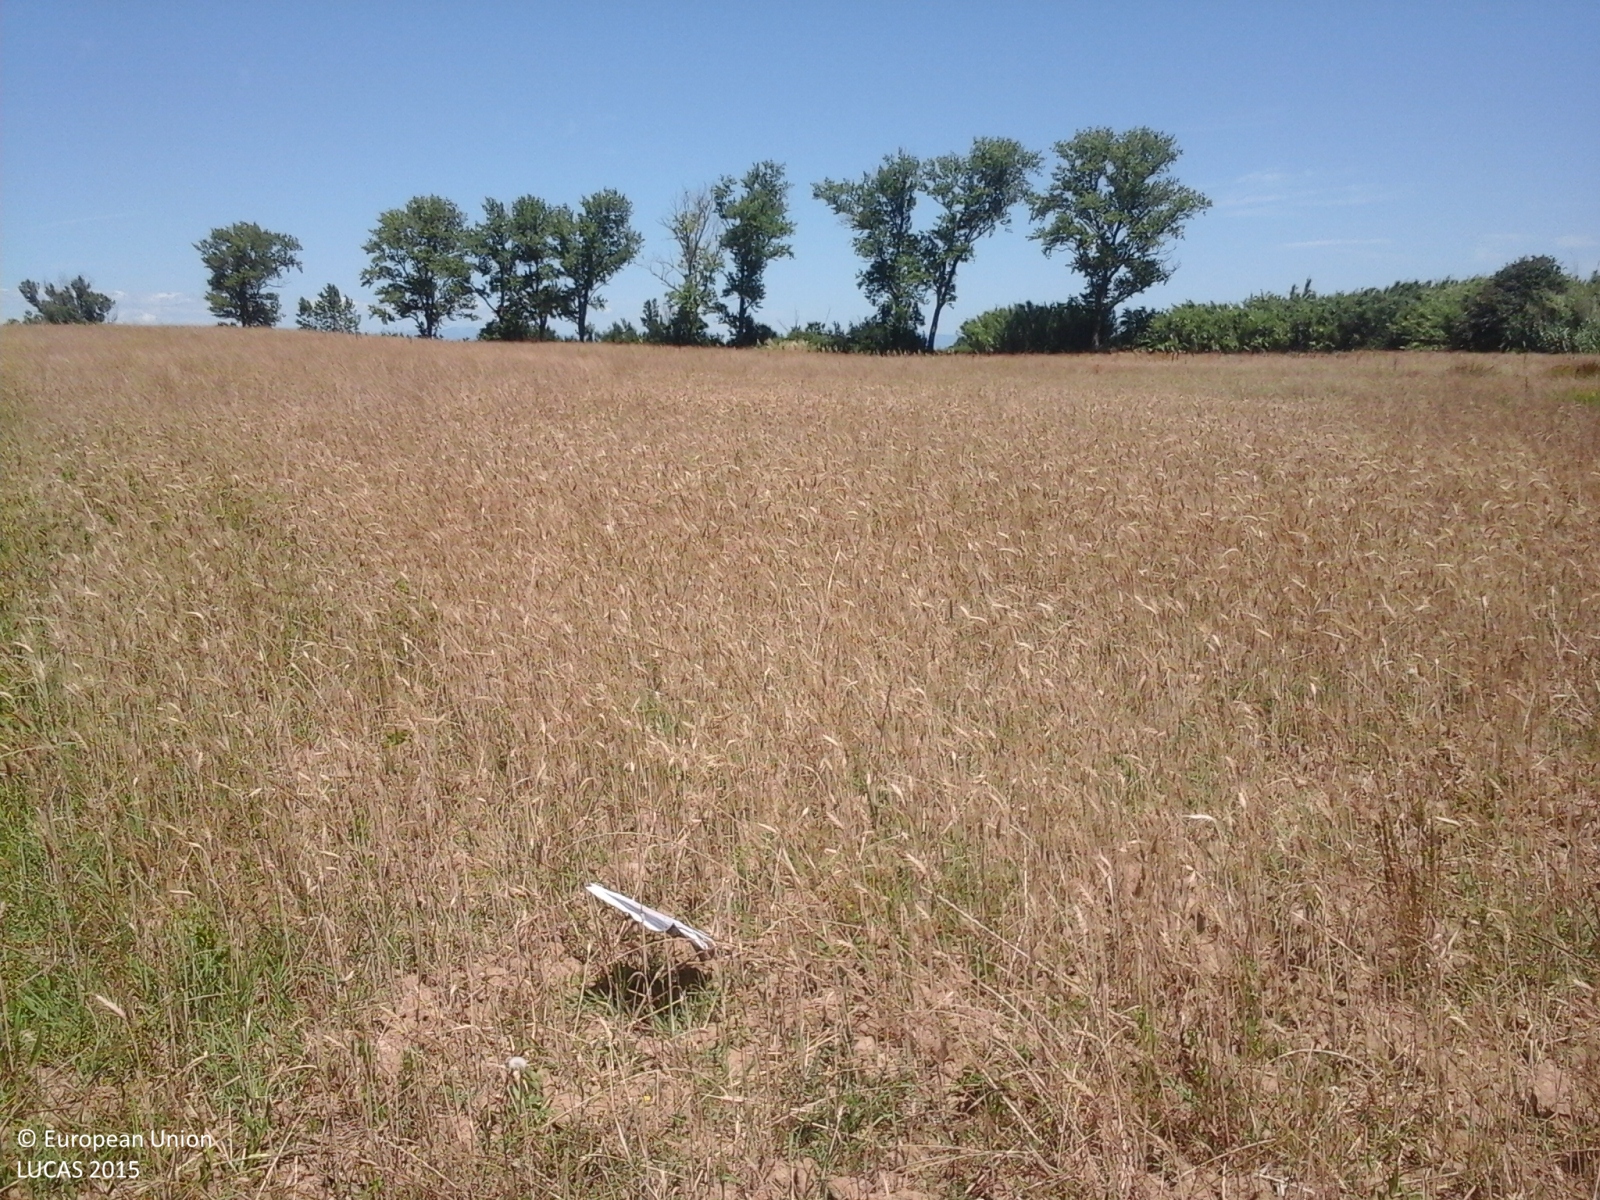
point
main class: Cropland
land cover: Durum wheat
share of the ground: > 75 %
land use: Agriculture (excluding fallow land and kitchen gardens)
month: June
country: IT
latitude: 43.6092
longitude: 10.5807
